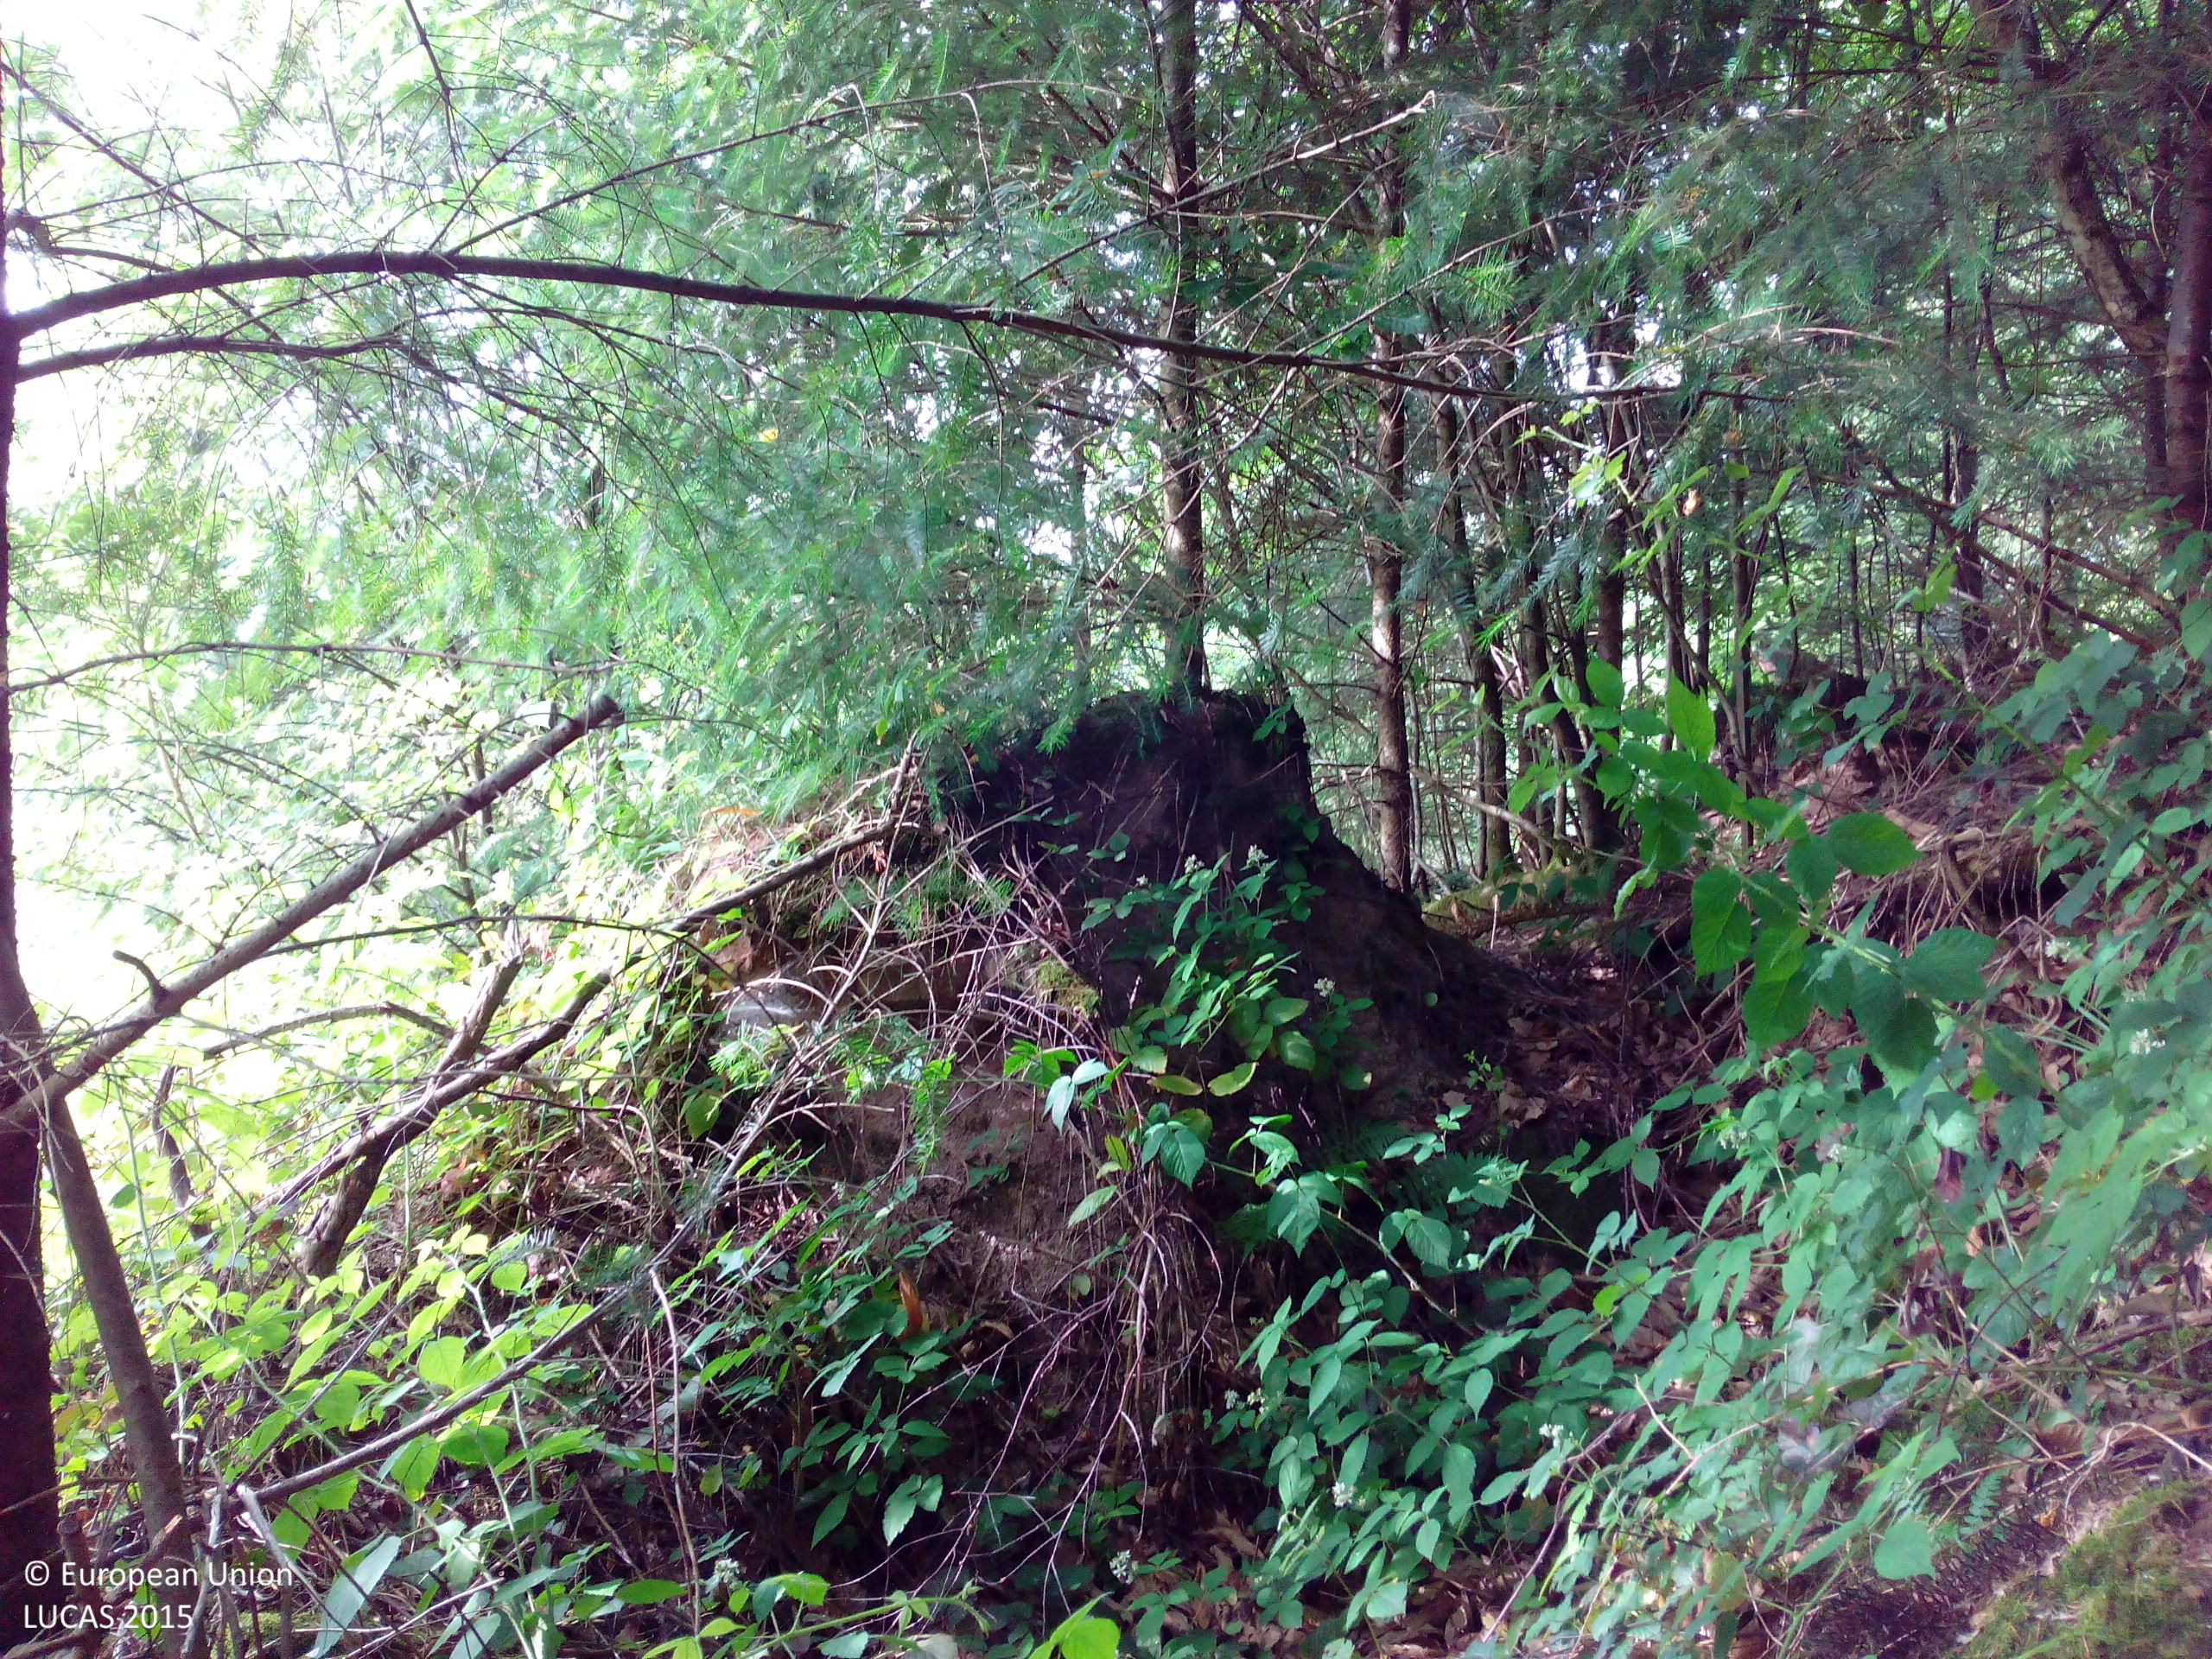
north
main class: Woodland
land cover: Spruce dominated mixed woodland
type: hemiboreal forest and nemoral coniferous forest and mixed broadleaved-coniferous forest
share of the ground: > 75 %
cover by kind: coniferous forest trees 60 %, broadleaved forest trees 40 %
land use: Forestry
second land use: Amenities, museums, leisure
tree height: > 5 m
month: June
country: DE
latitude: 48.7307
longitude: 8.1925
